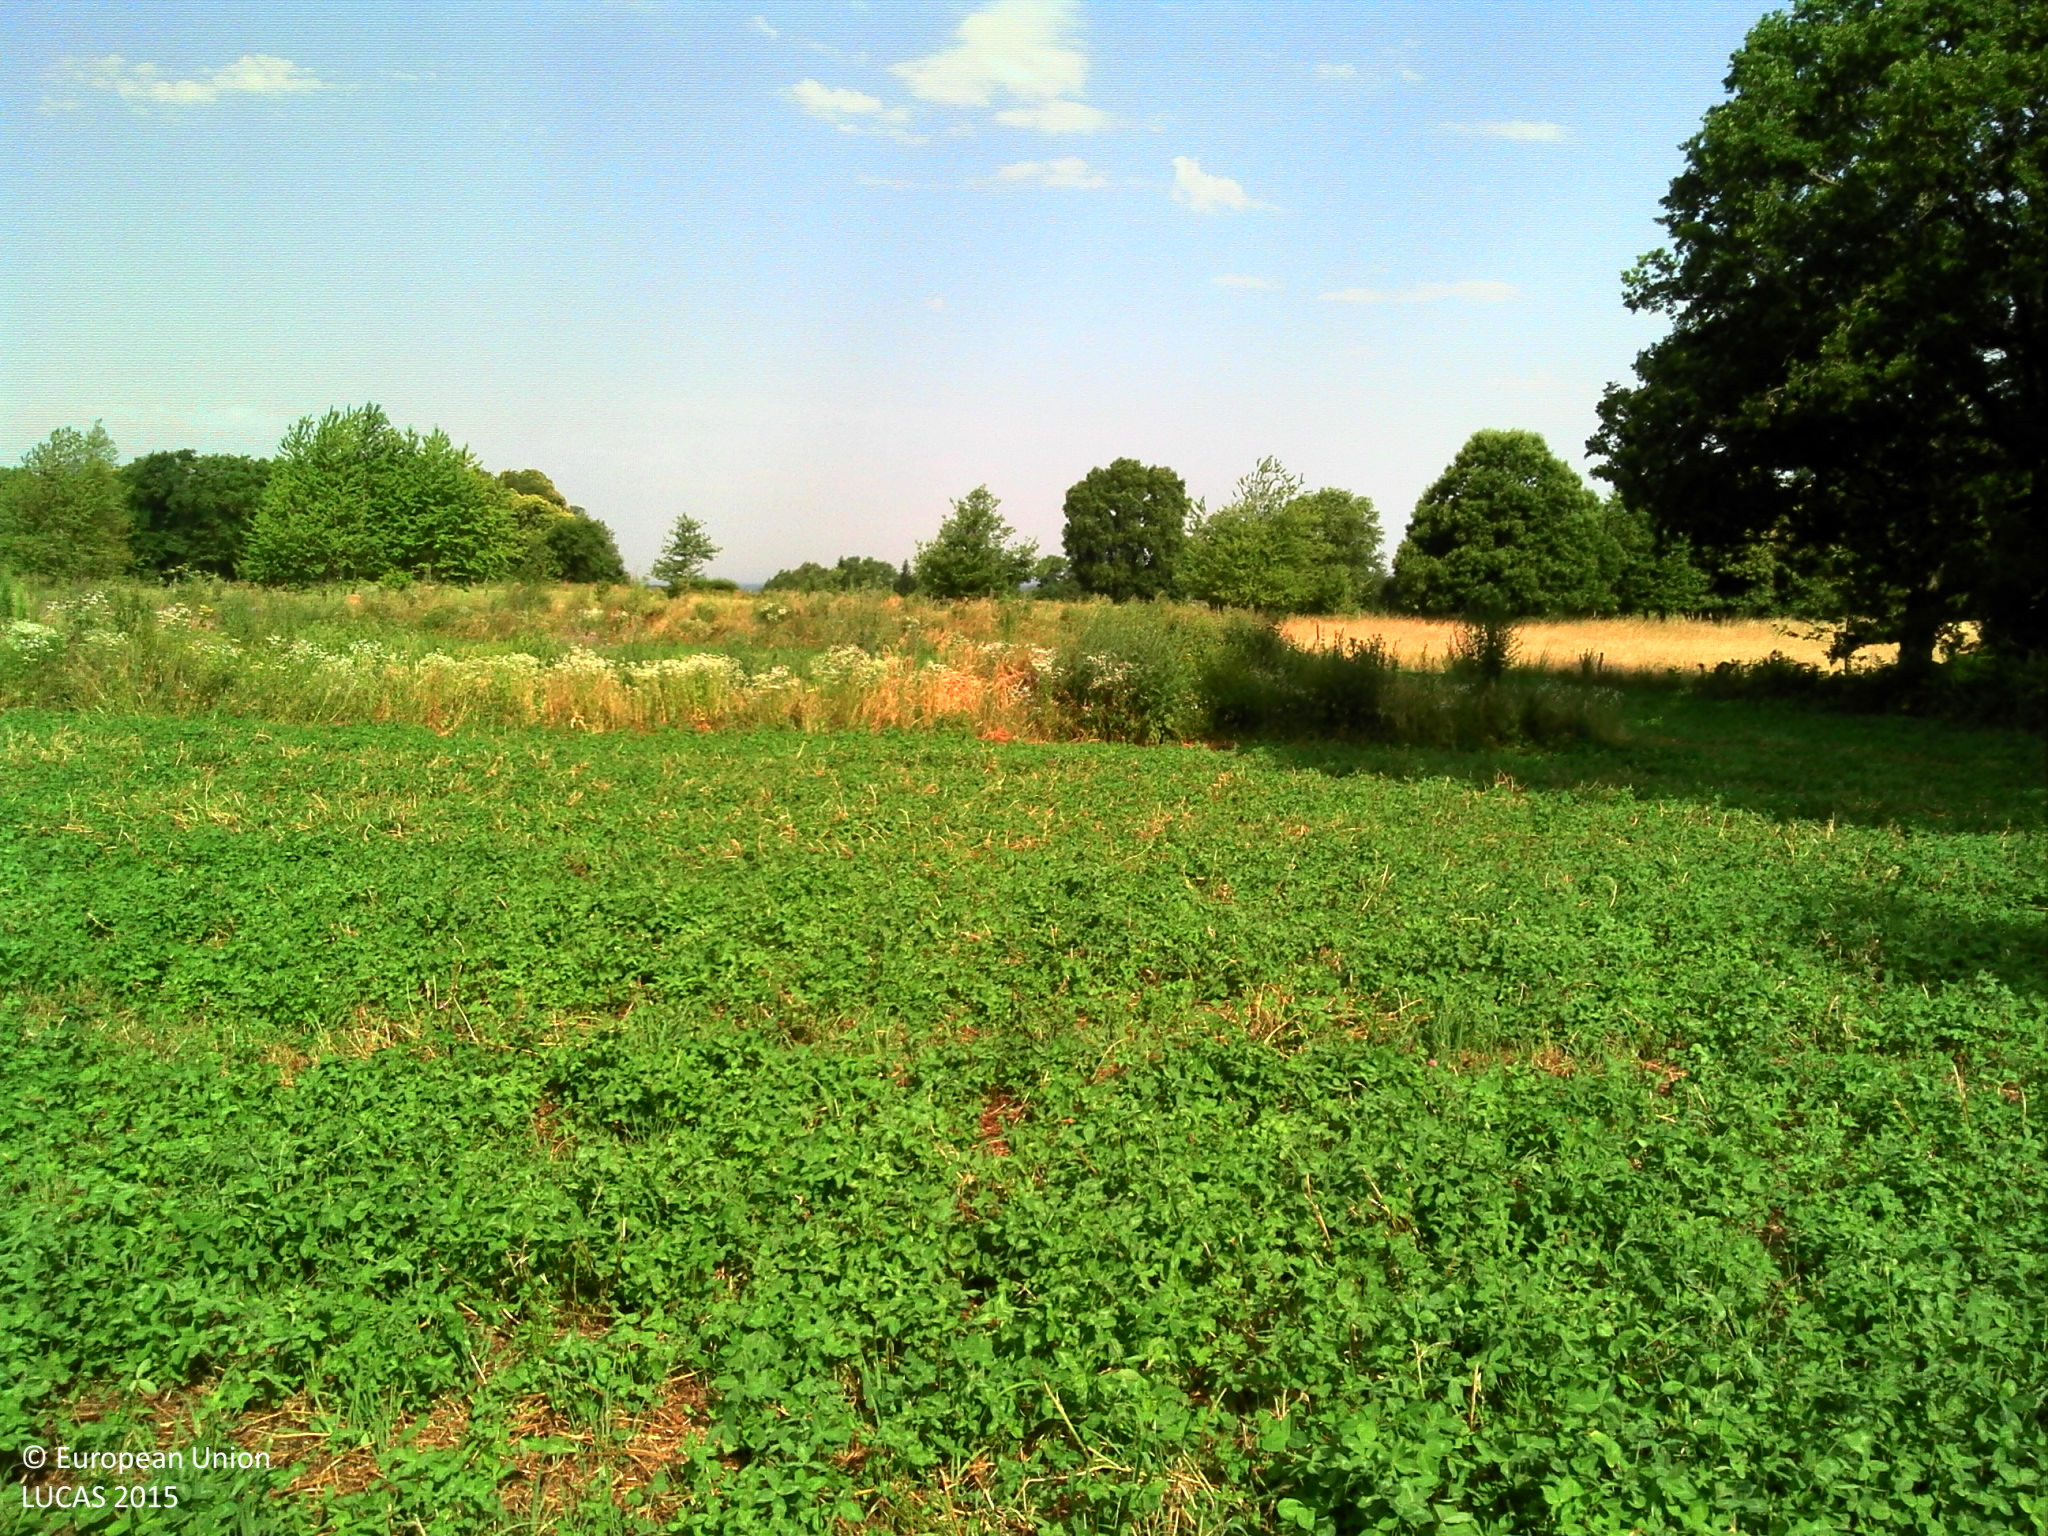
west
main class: Cropland
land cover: Clovers
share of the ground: > 75 %
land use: Agriculture (excluding fallow land and kitchen gardens)
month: July
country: FR
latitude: 46.0940
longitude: 1.3892
